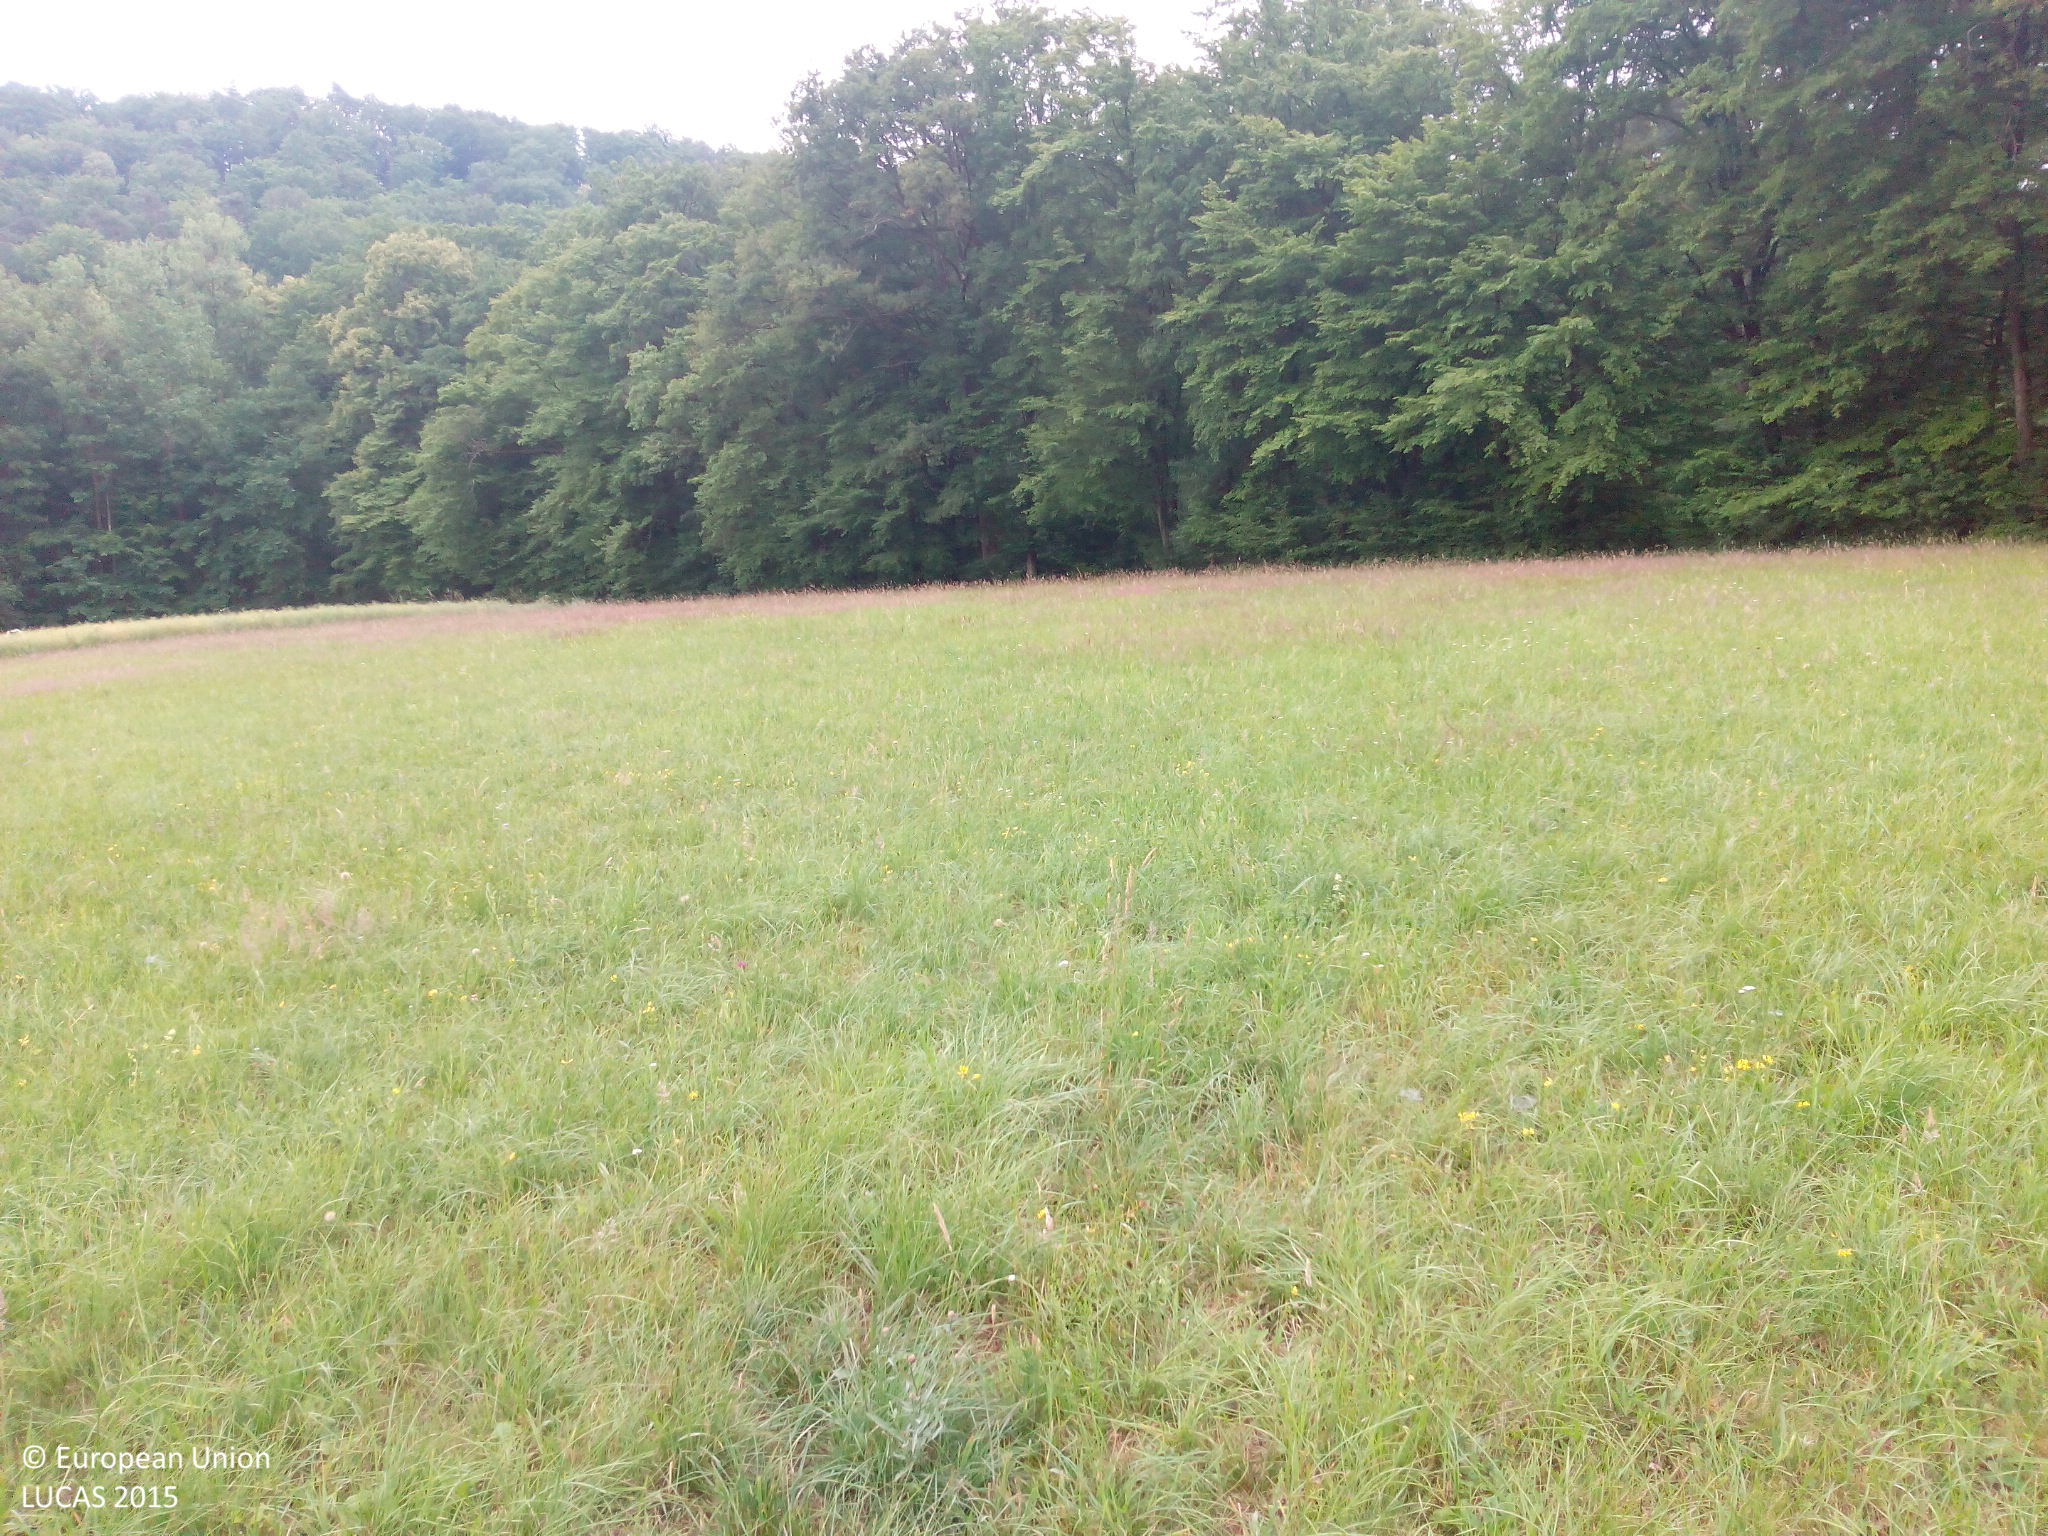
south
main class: Grassland
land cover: Grassland without tree/shrub cover
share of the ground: > 75 %
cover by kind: herbaceous plants 100 %
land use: Agriculture (excluding fallow land and kitchen gardens)
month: June
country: DE
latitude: 49.9667
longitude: 10.6272
